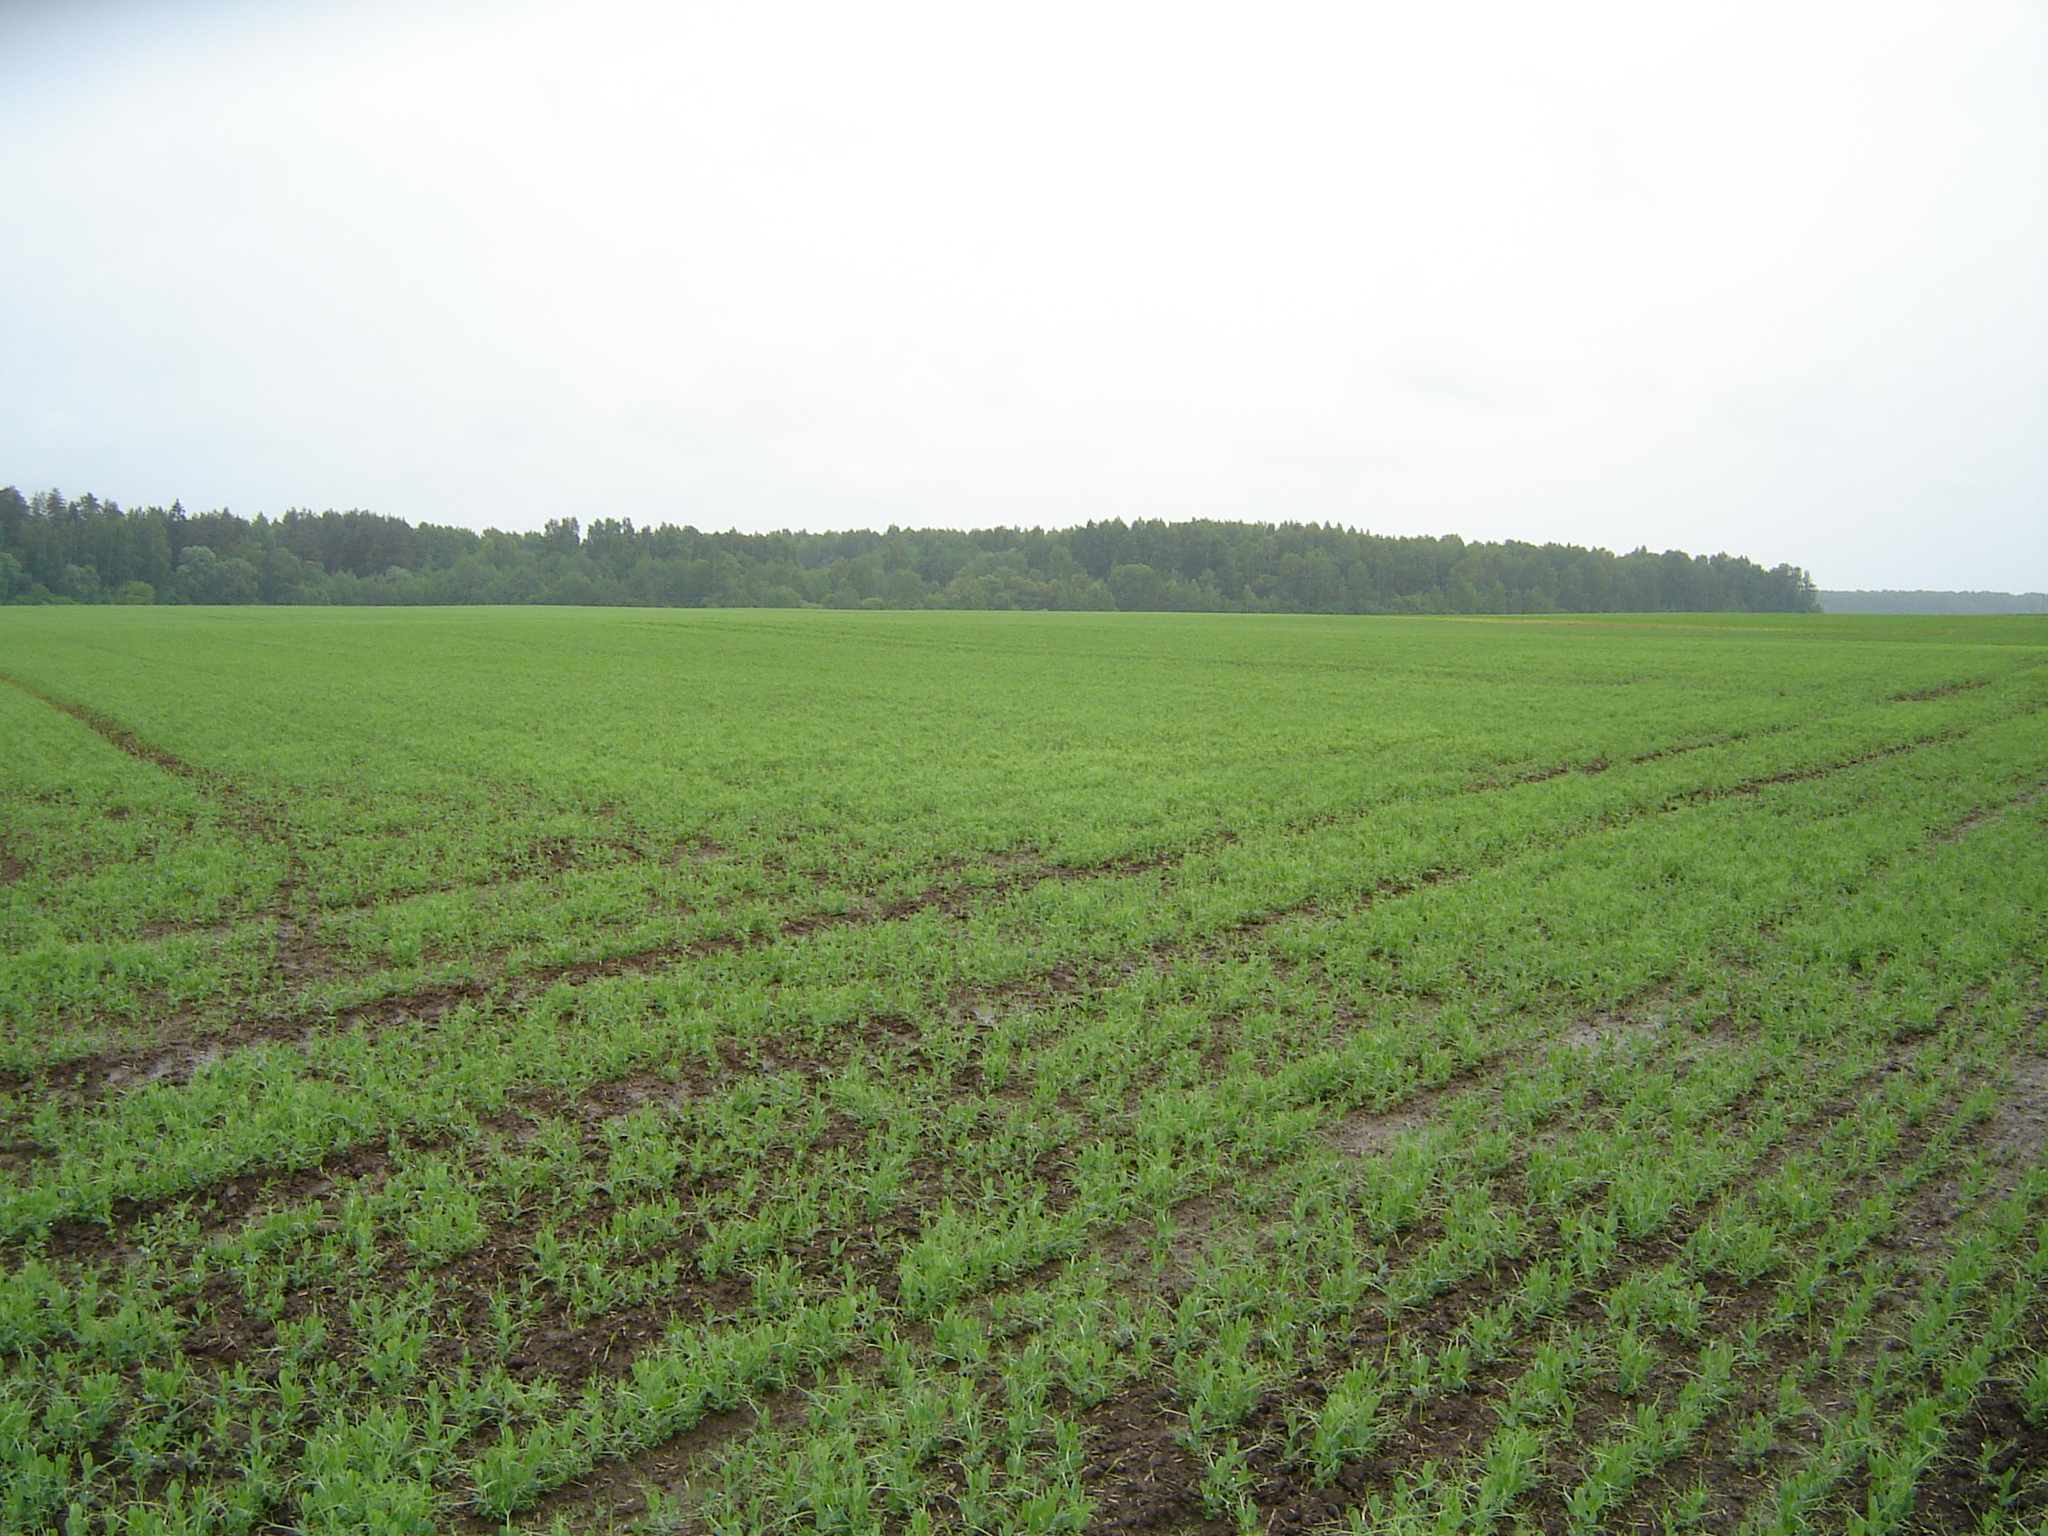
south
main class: Cropland
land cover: Dry pulses
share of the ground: > 75 %
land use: Agriculture (excluding fallow land and kitchen gardens)
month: May
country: LT
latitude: 55.9996
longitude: 25.2692
